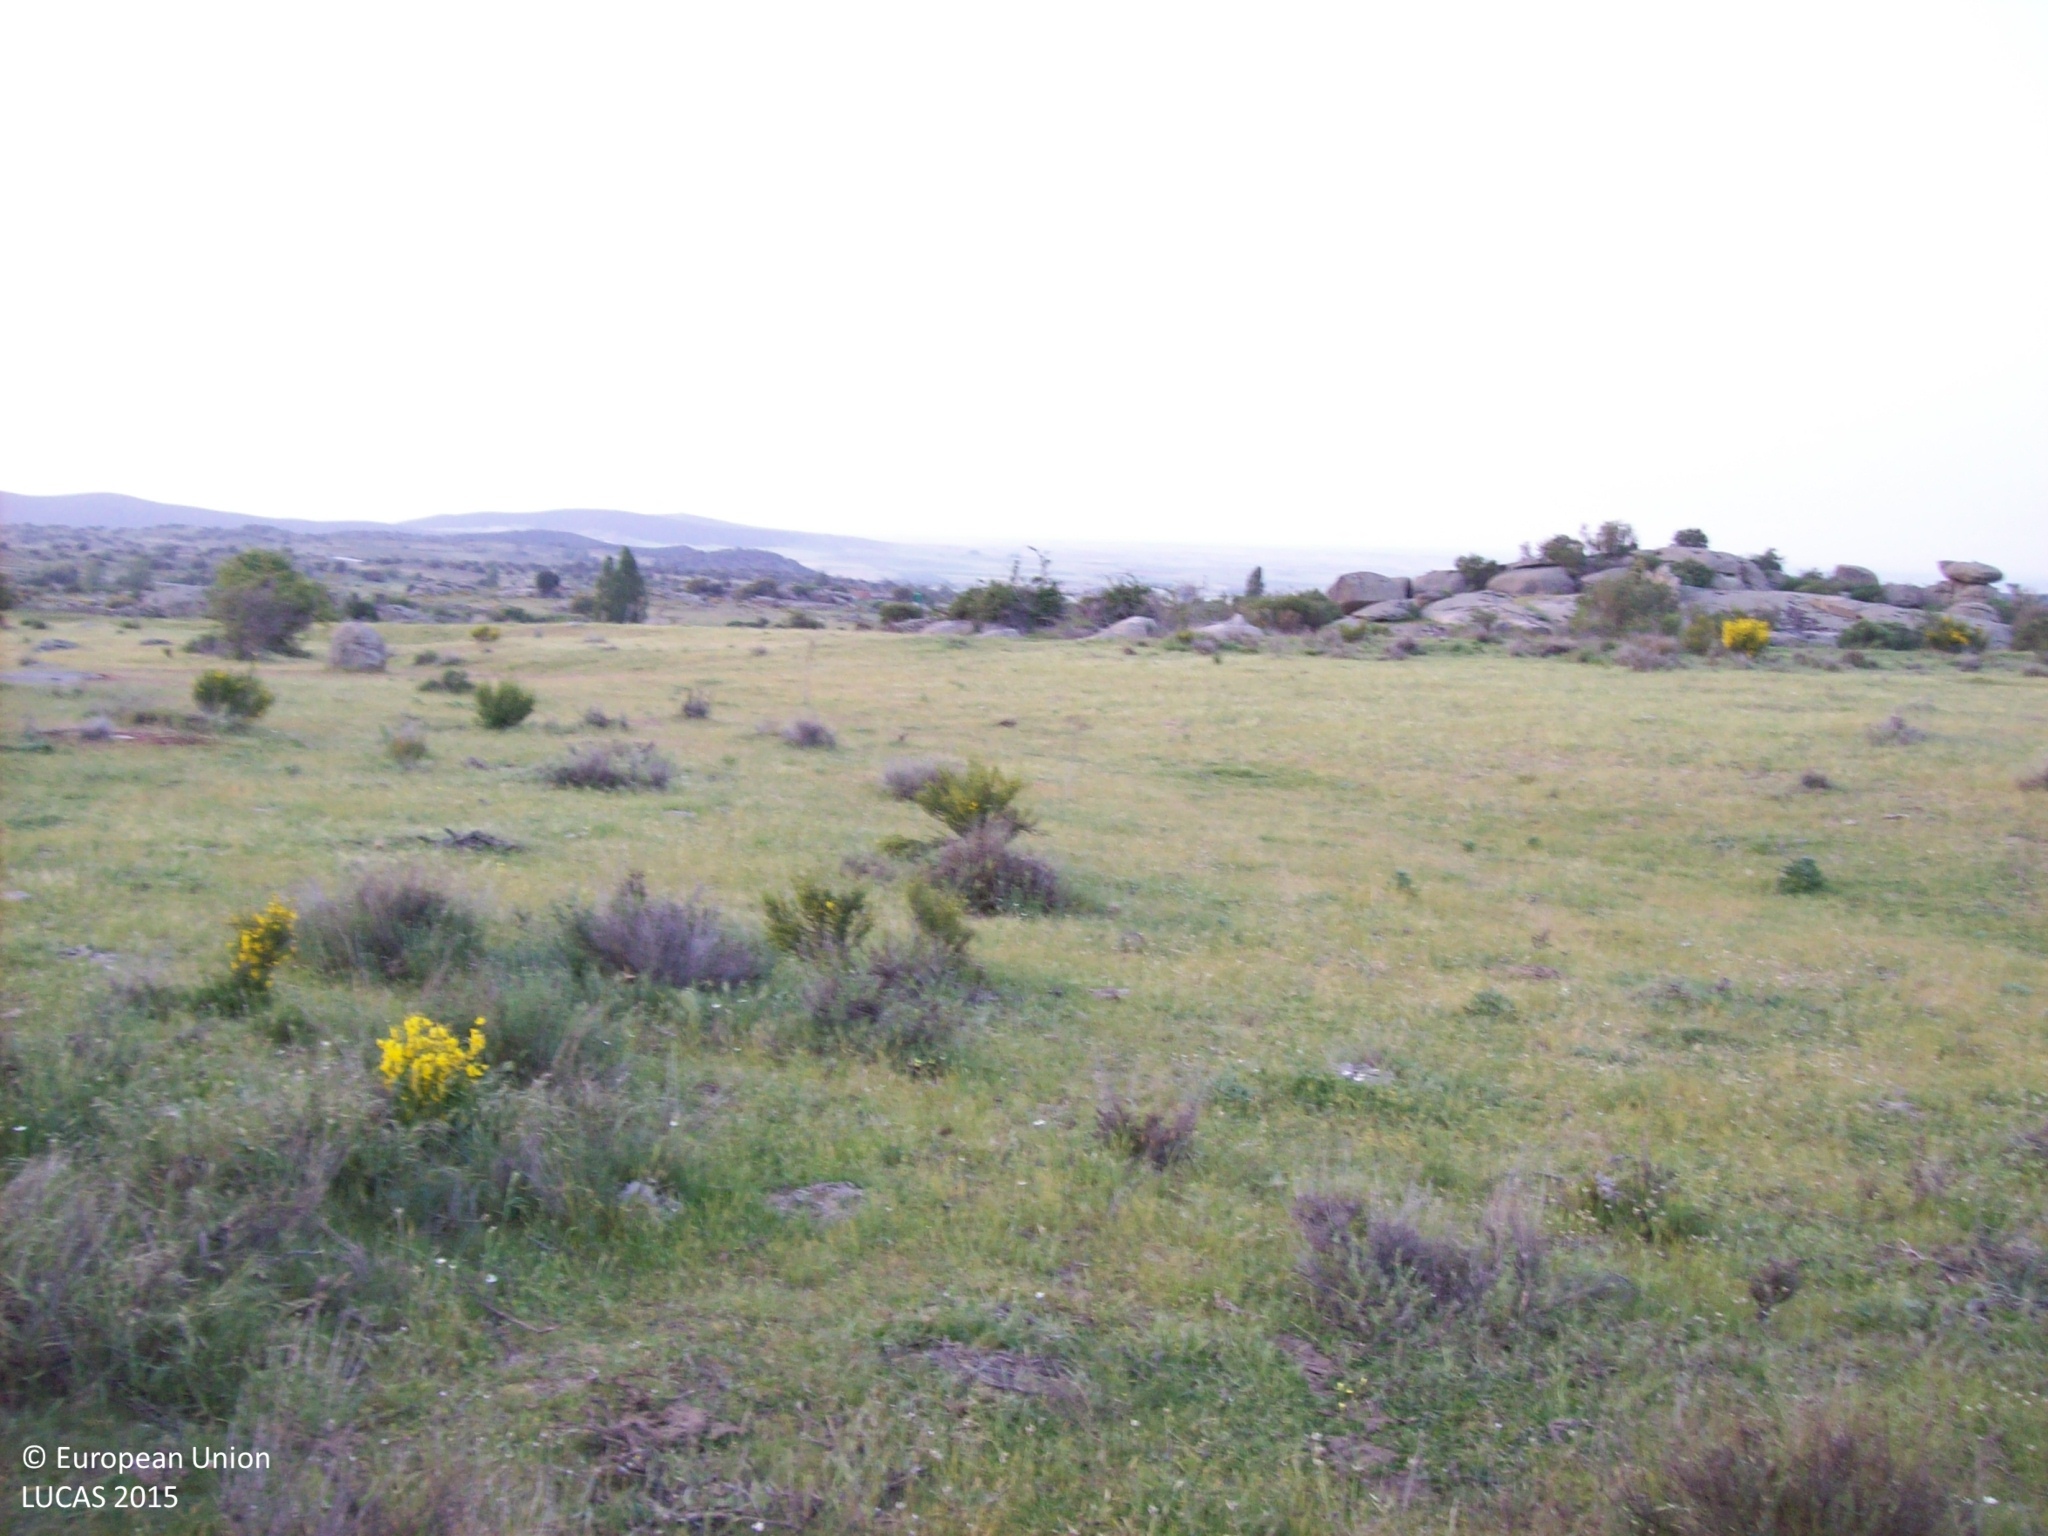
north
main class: Shrubland
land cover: Shrubland without tree cover
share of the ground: 25 - 50 %
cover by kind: herbaceous plants 65 %, shrubs 30 %, consolidated bare surface 5 %
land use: Agriculture (excluding fallow land and kitchen gardens)
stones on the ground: < 10 %
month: May
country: ES
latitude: 40.6921
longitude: -4.9589
